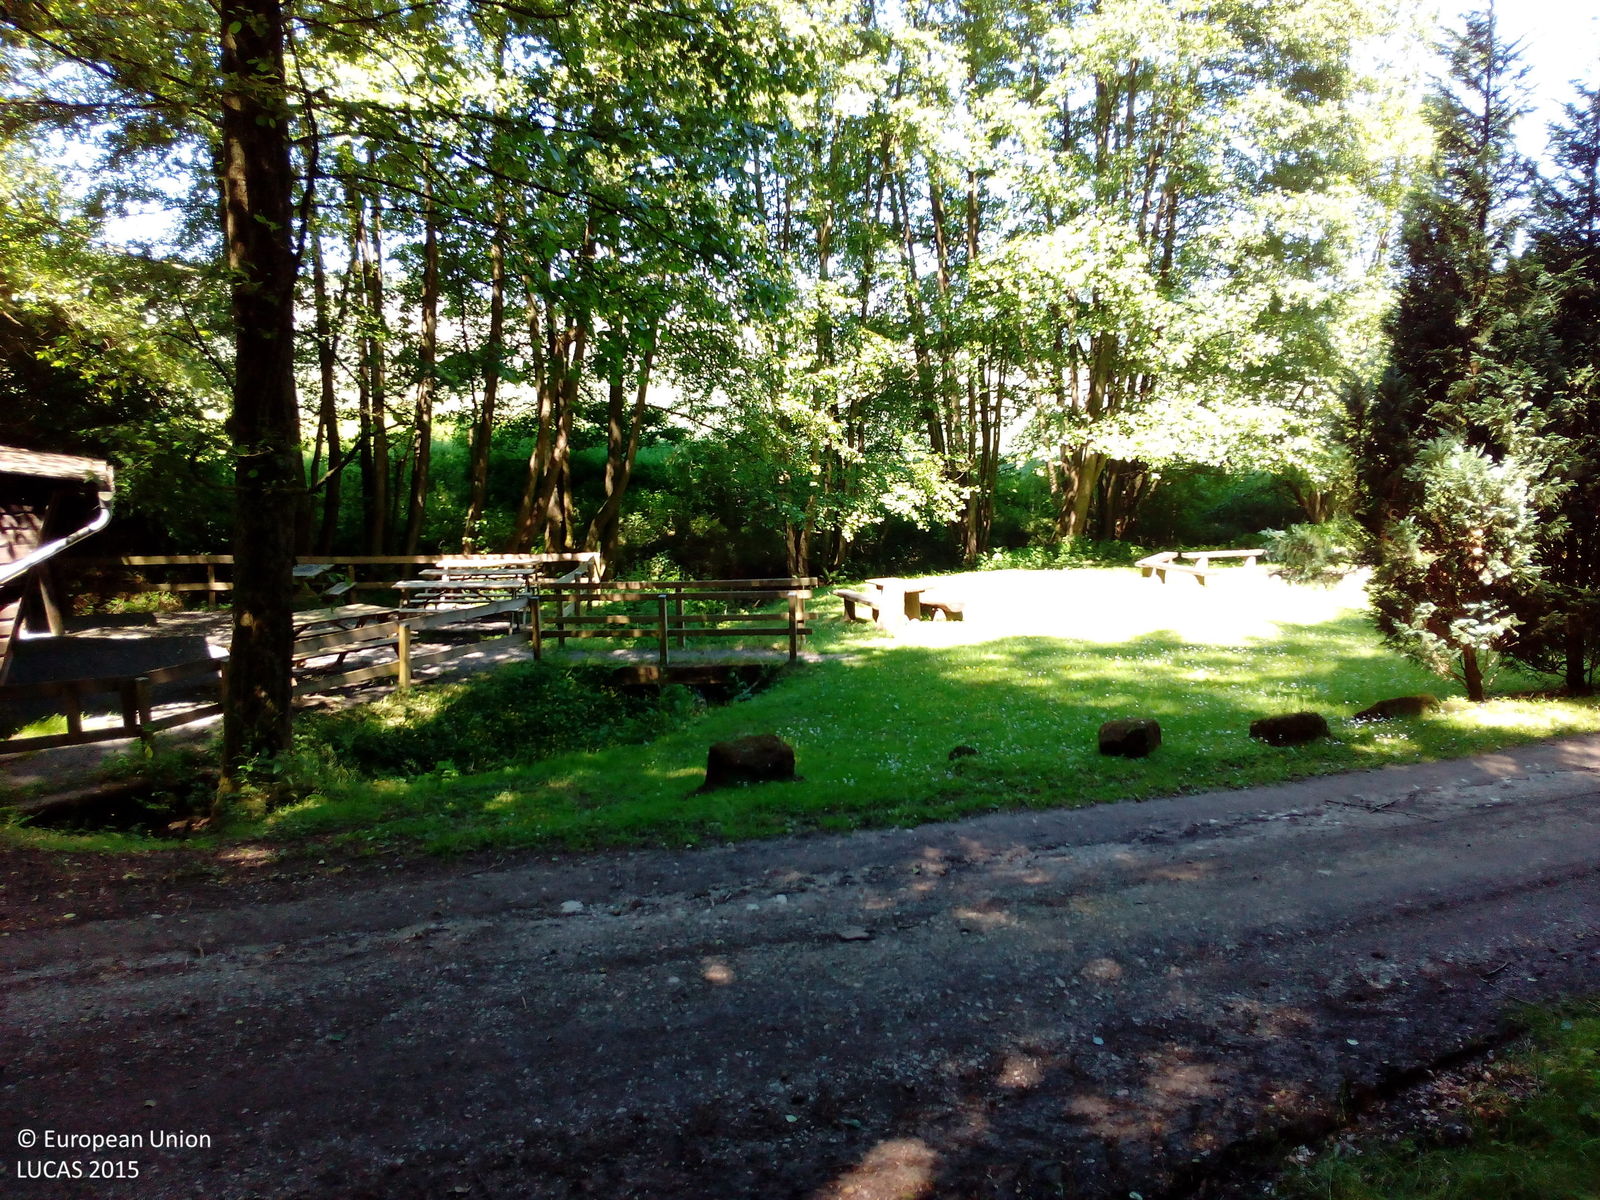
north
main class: Woodland
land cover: Other mixed woodland
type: hemiboreal forest and nemoral coniferous forest and mixed broadleaved-coniferous forest
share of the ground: > 75 %
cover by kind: broadleaved forest trees 75 %, coniferous forest trees 25 %
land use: Forestry
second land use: Amenities, museums, leisure
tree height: > 5 m
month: June
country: DE
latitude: 51.8018
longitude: 9.6666
